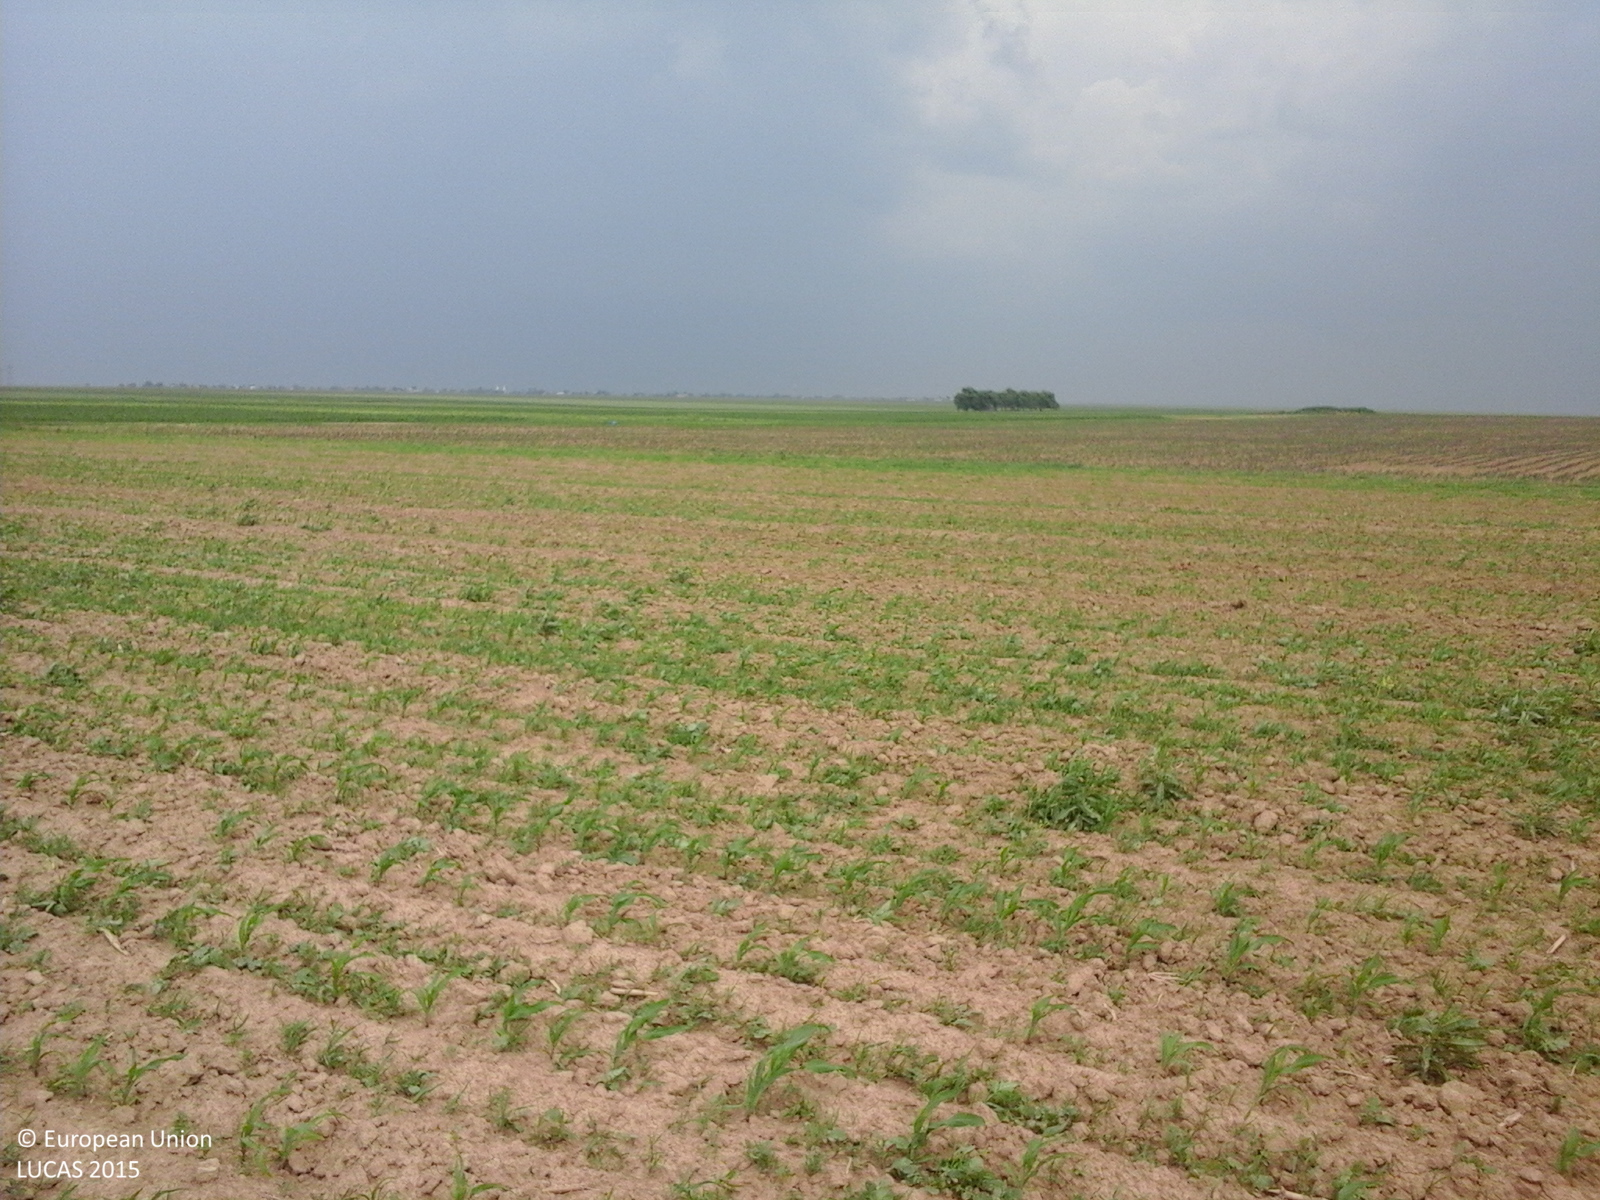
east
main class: Cropland
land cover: Maize
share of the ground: 25 - 50 %
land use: Agriculture (excluding fallow land and kitchen gardens)
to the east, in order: Maize; Paved roads, cycling and walking lanes; Maize; Sunflower; Maize
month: June
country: RO
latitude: 47.0938
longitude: 26.7587
